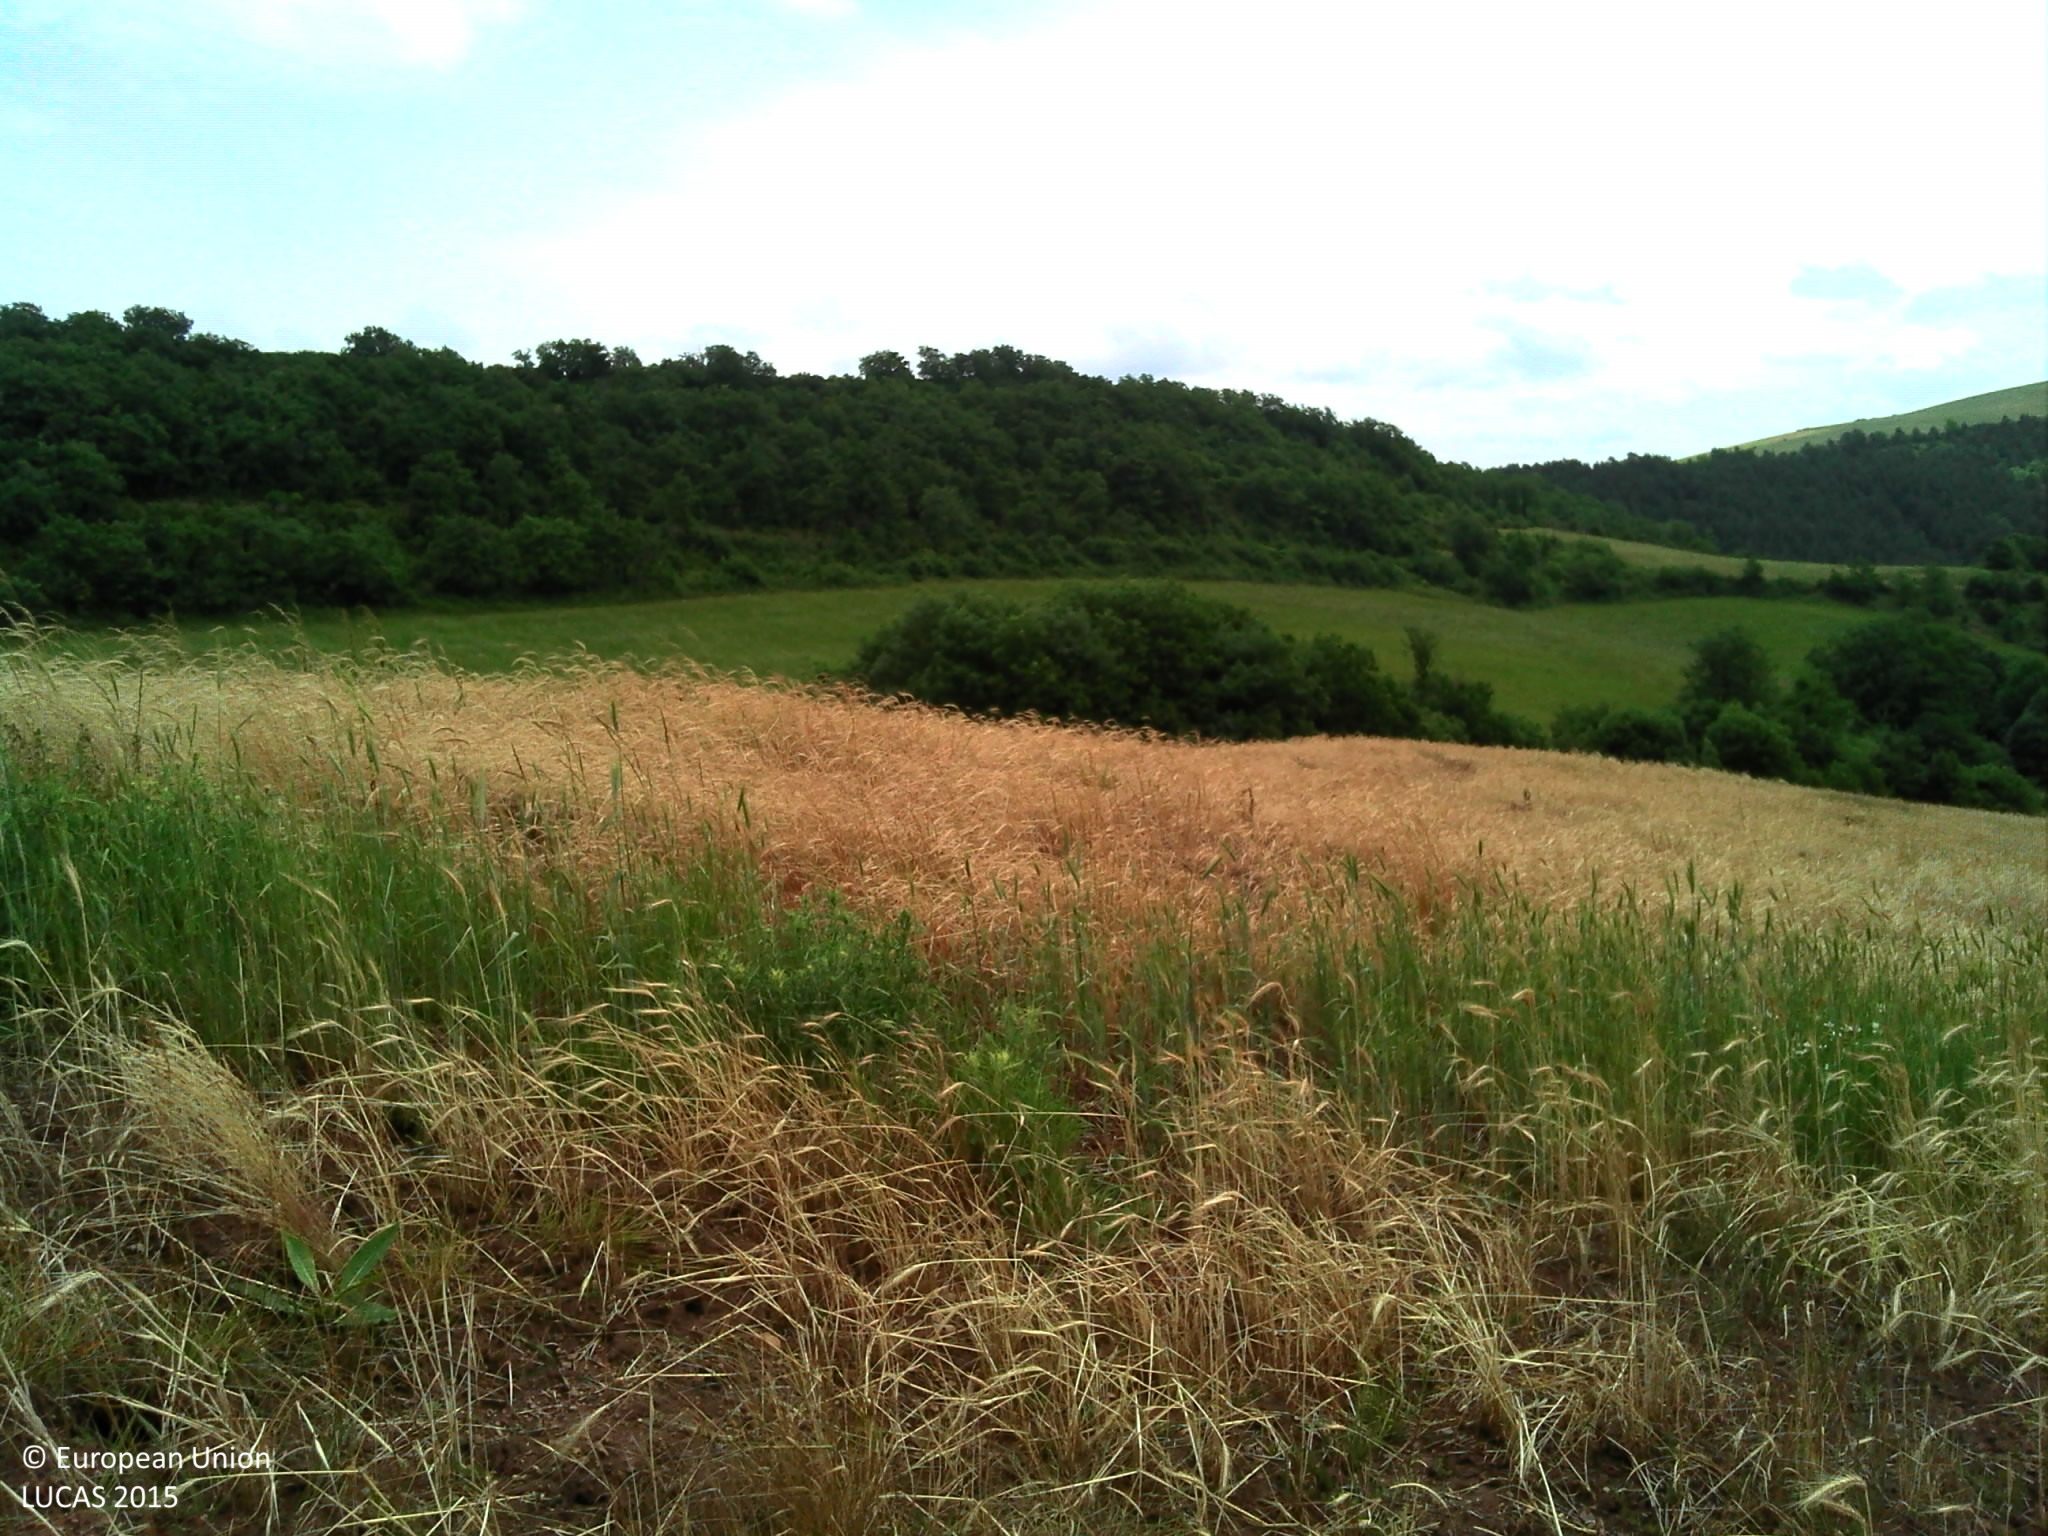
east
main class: Cropland
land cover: Barley
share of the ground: > 75 %
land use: Agriculture (excluding fallow land and kitchen gardens)
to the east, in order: Barley; Broadleaved woodland; Rivers and streams; Broadleaved woodland; Grassland without tree/shrub cover; Broadleaved woodland; Grassland without tree/shrub cover
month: June
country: FR
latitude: 44.2983
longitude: 3.0487
